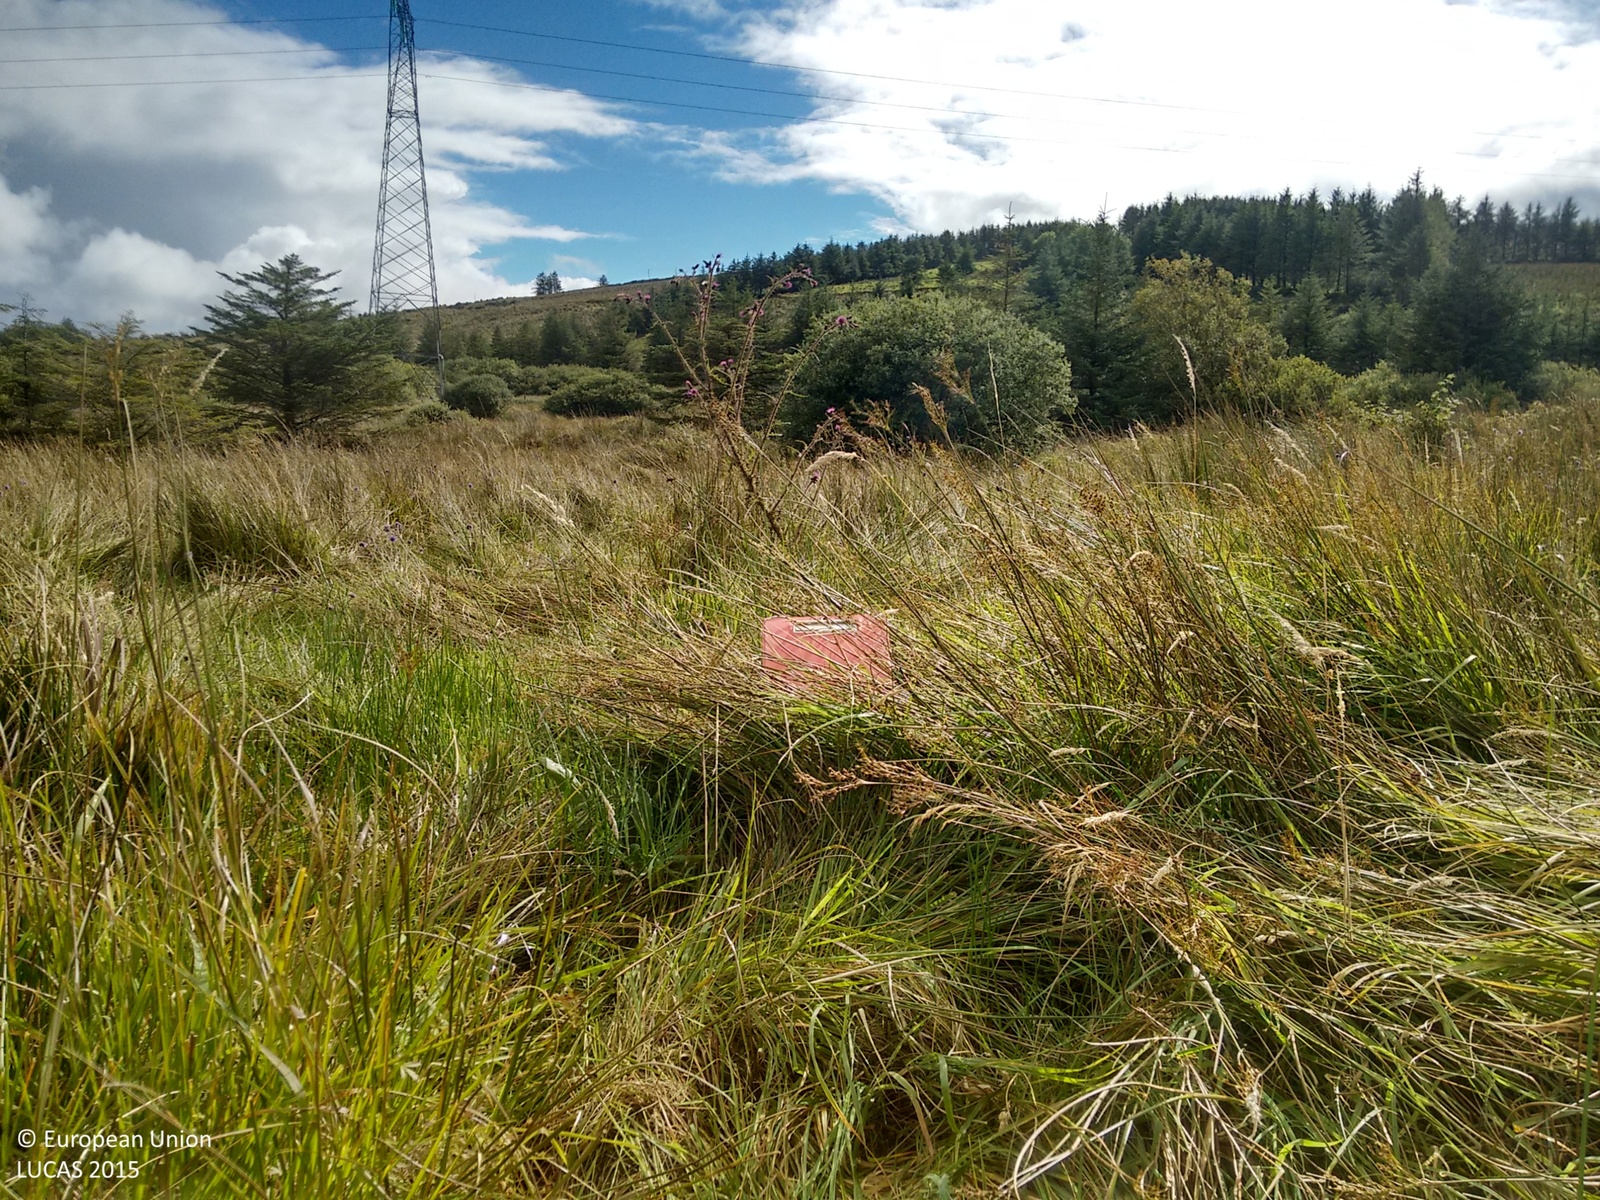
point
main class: Grassland
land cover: Grassland without tree/shrub cover
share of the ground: > 75 %
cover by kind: herbaceous plants 95 %, shrubs 5 %
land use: Agriculture (excluding fallow land and kitchen gardens)
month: September
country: IE
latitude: 52.2755
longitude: -9.3839
